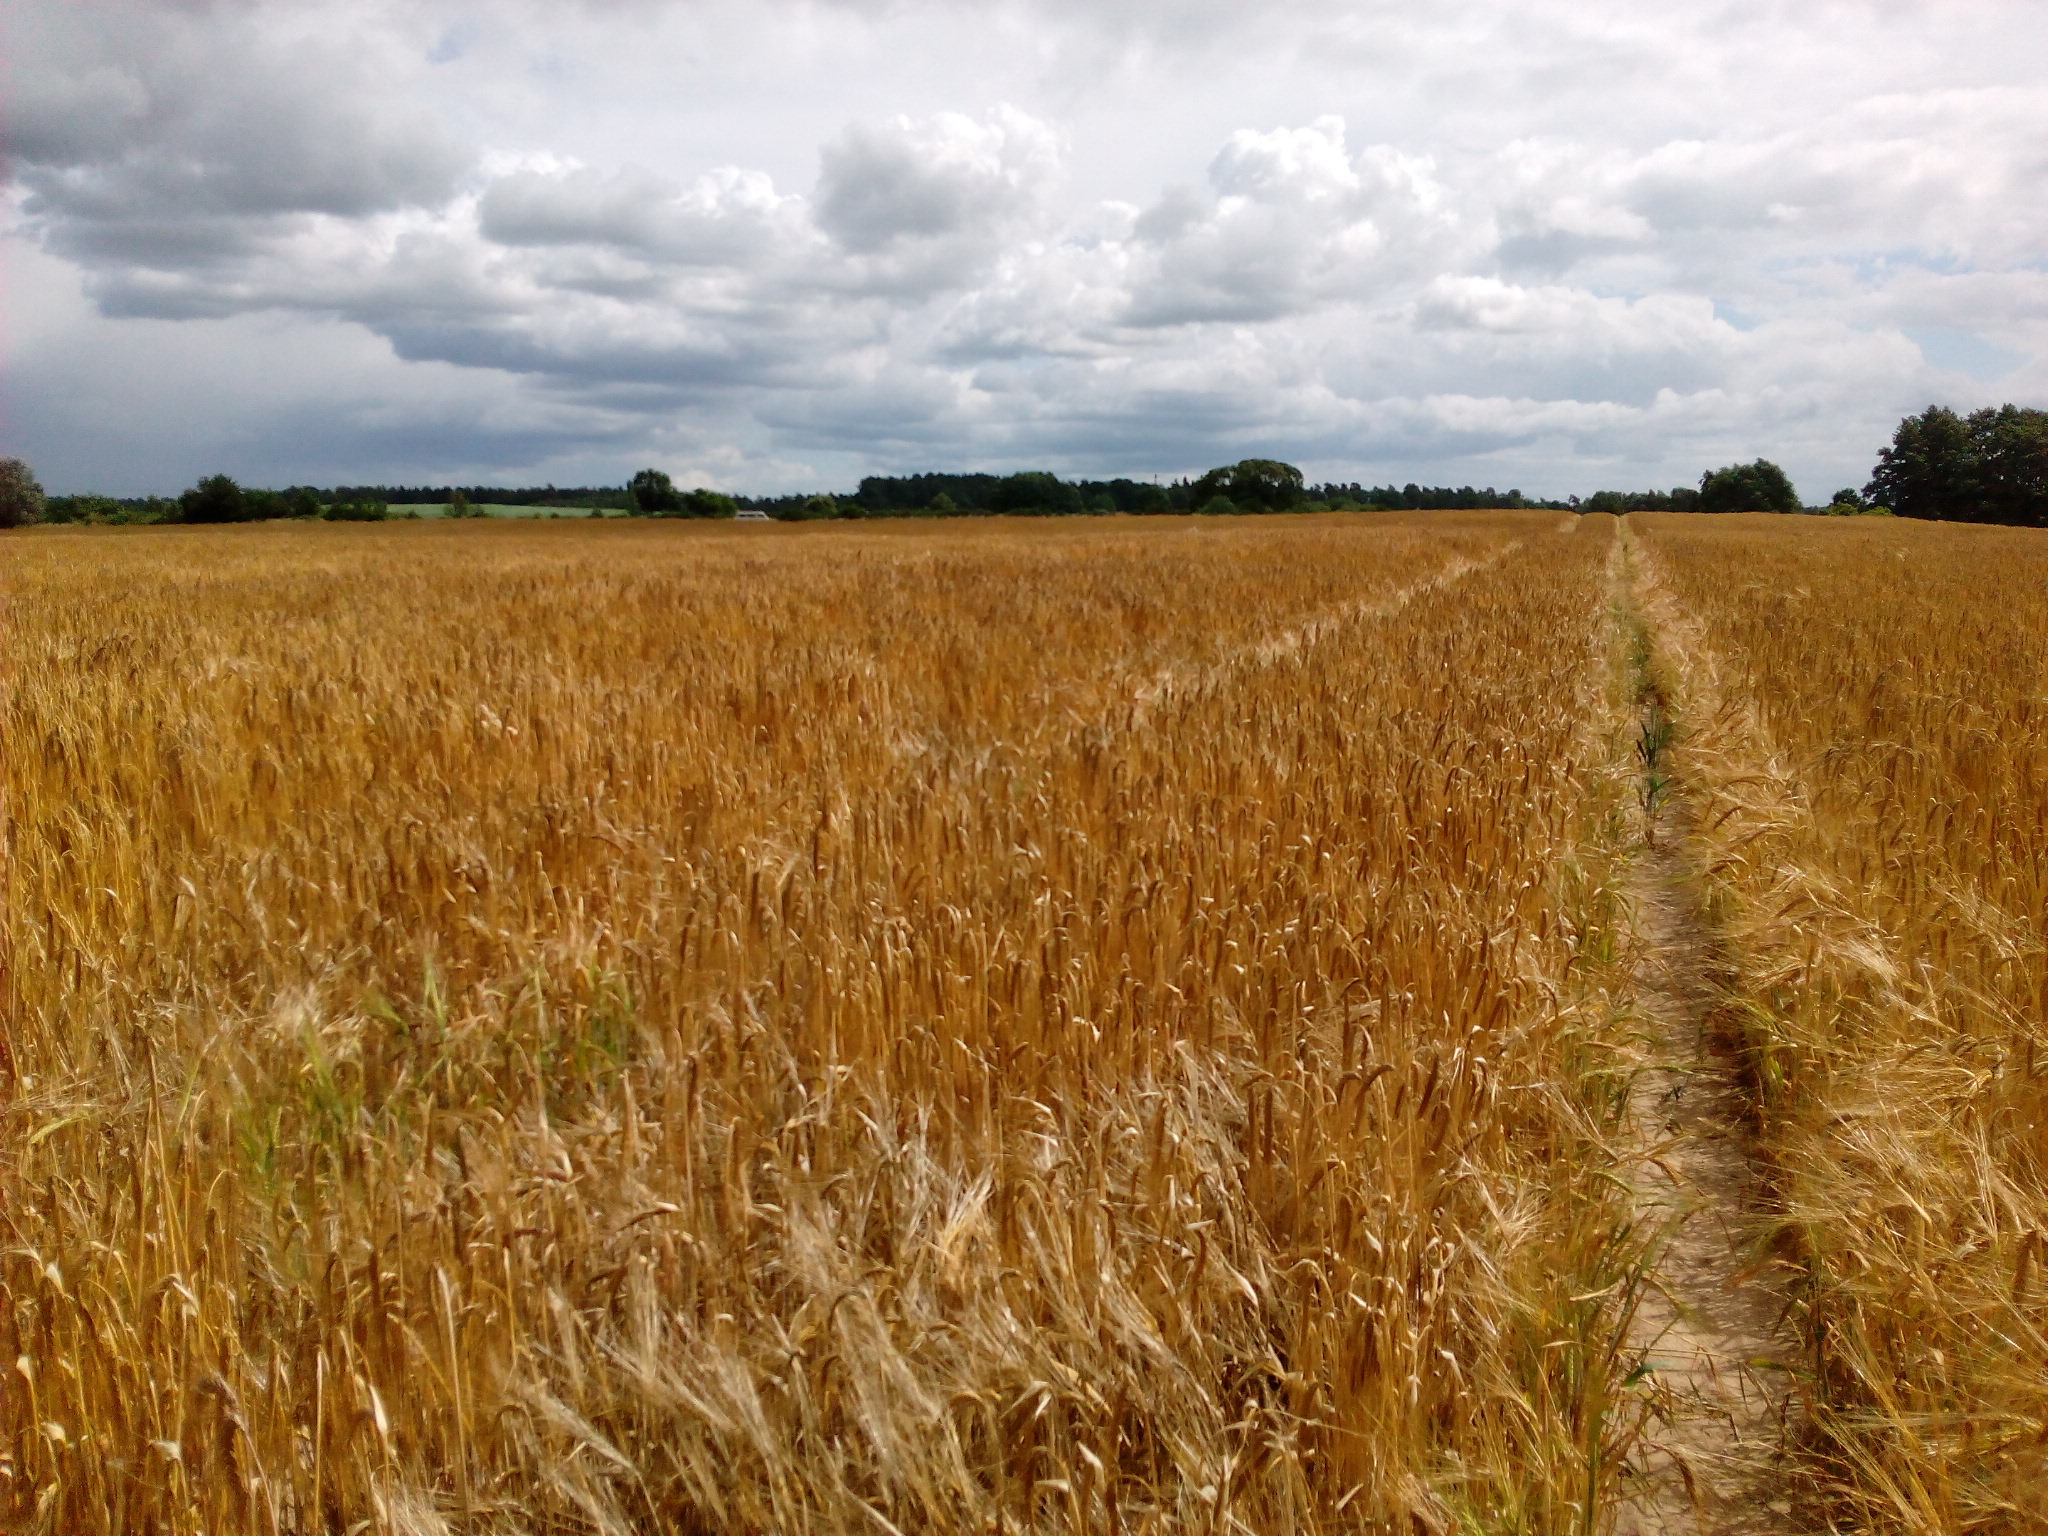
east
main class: Cropland
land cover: Barley
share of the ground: > 75 %
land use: Agriculture (excluding fallow land and kitchen gardens)
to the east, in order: Barley; Grass margins; Electric lines; Grass margins; Paved roads, cycling and walking lanes; Grass margins; Shrubland with sparse tree cover; Maize
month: July
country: DE
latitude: 53.4340
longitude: 14.2906
